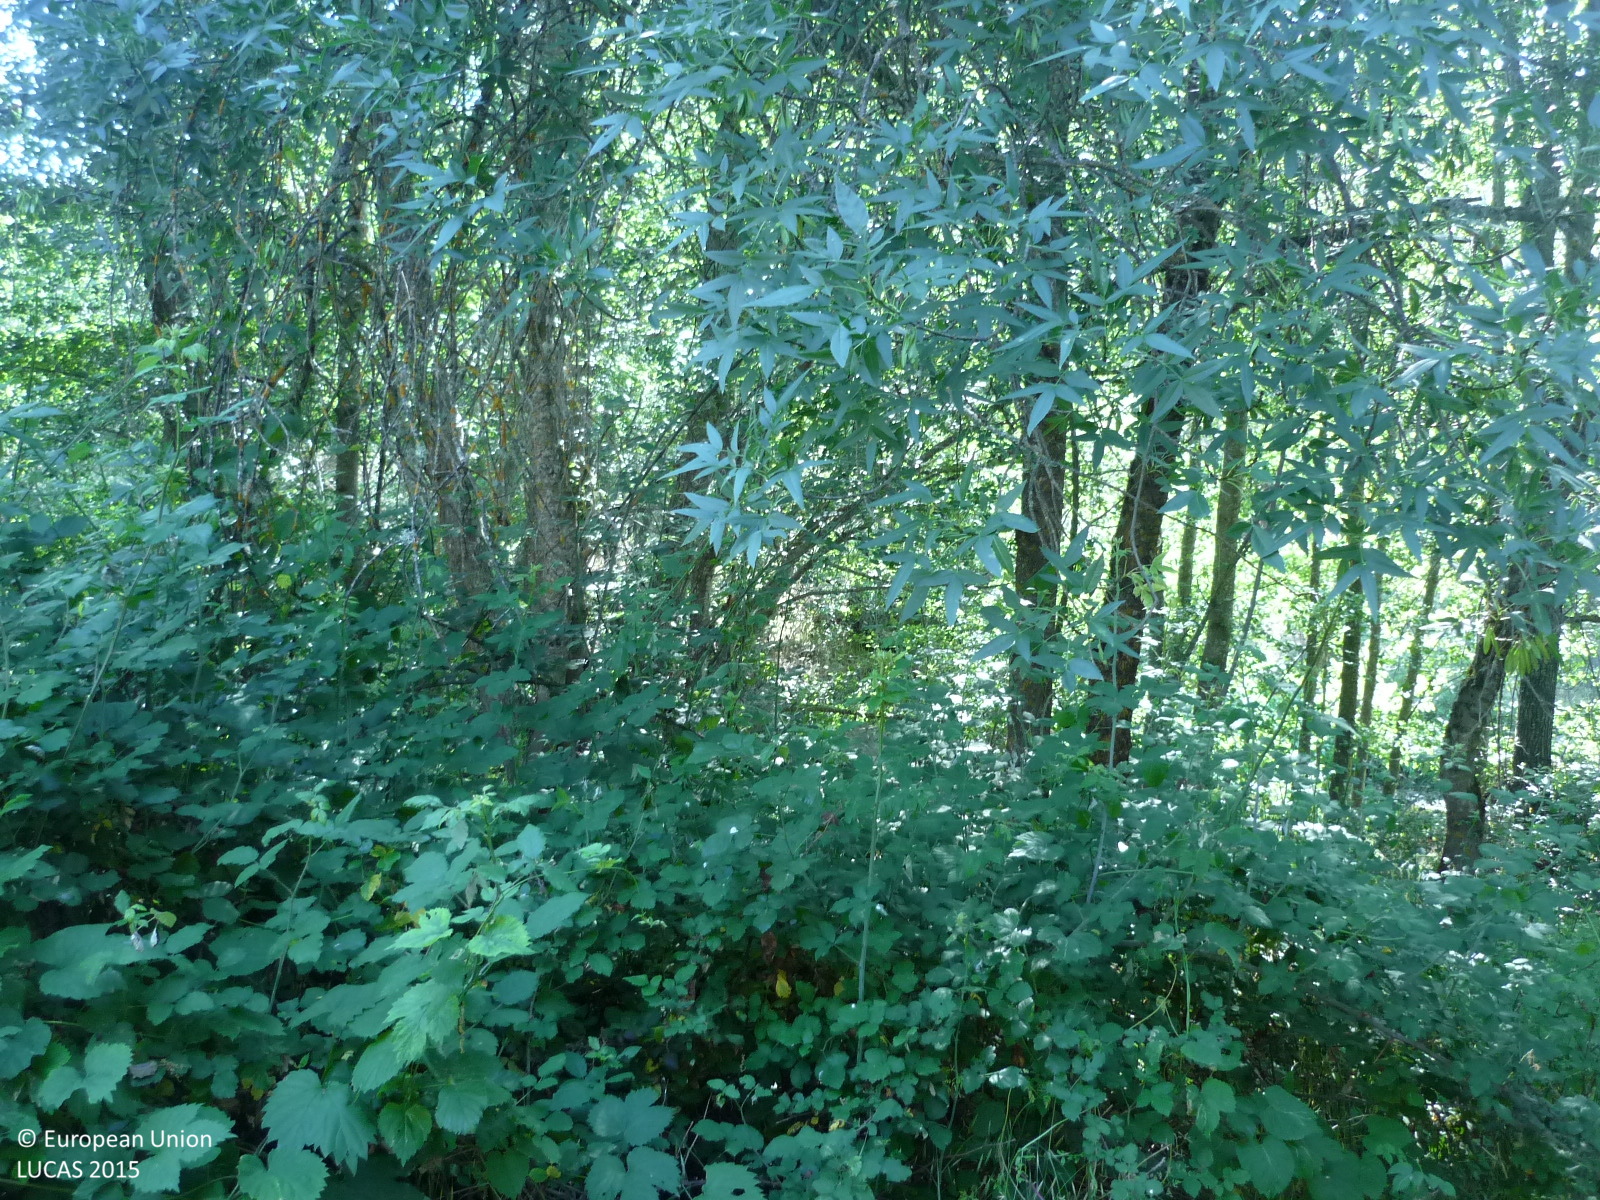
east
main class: Woodland
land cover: Broadleaved woodland
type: mesophytic deciduous forest
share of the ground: > 75 %
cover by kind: broadleaved forest trees 80 %, shrubs 10 %, herbaceous plants 10 %
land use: Semi-natural and natural areas not in use
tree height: < 5 m
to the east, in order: Broadleaved woodland; Grassland without tree/shrub cover; Inland fresh running water; Broadleaved woodland; Tracks; Broadleaved woodland
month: June
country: ES
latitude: 40.7229
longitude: -3.6197
